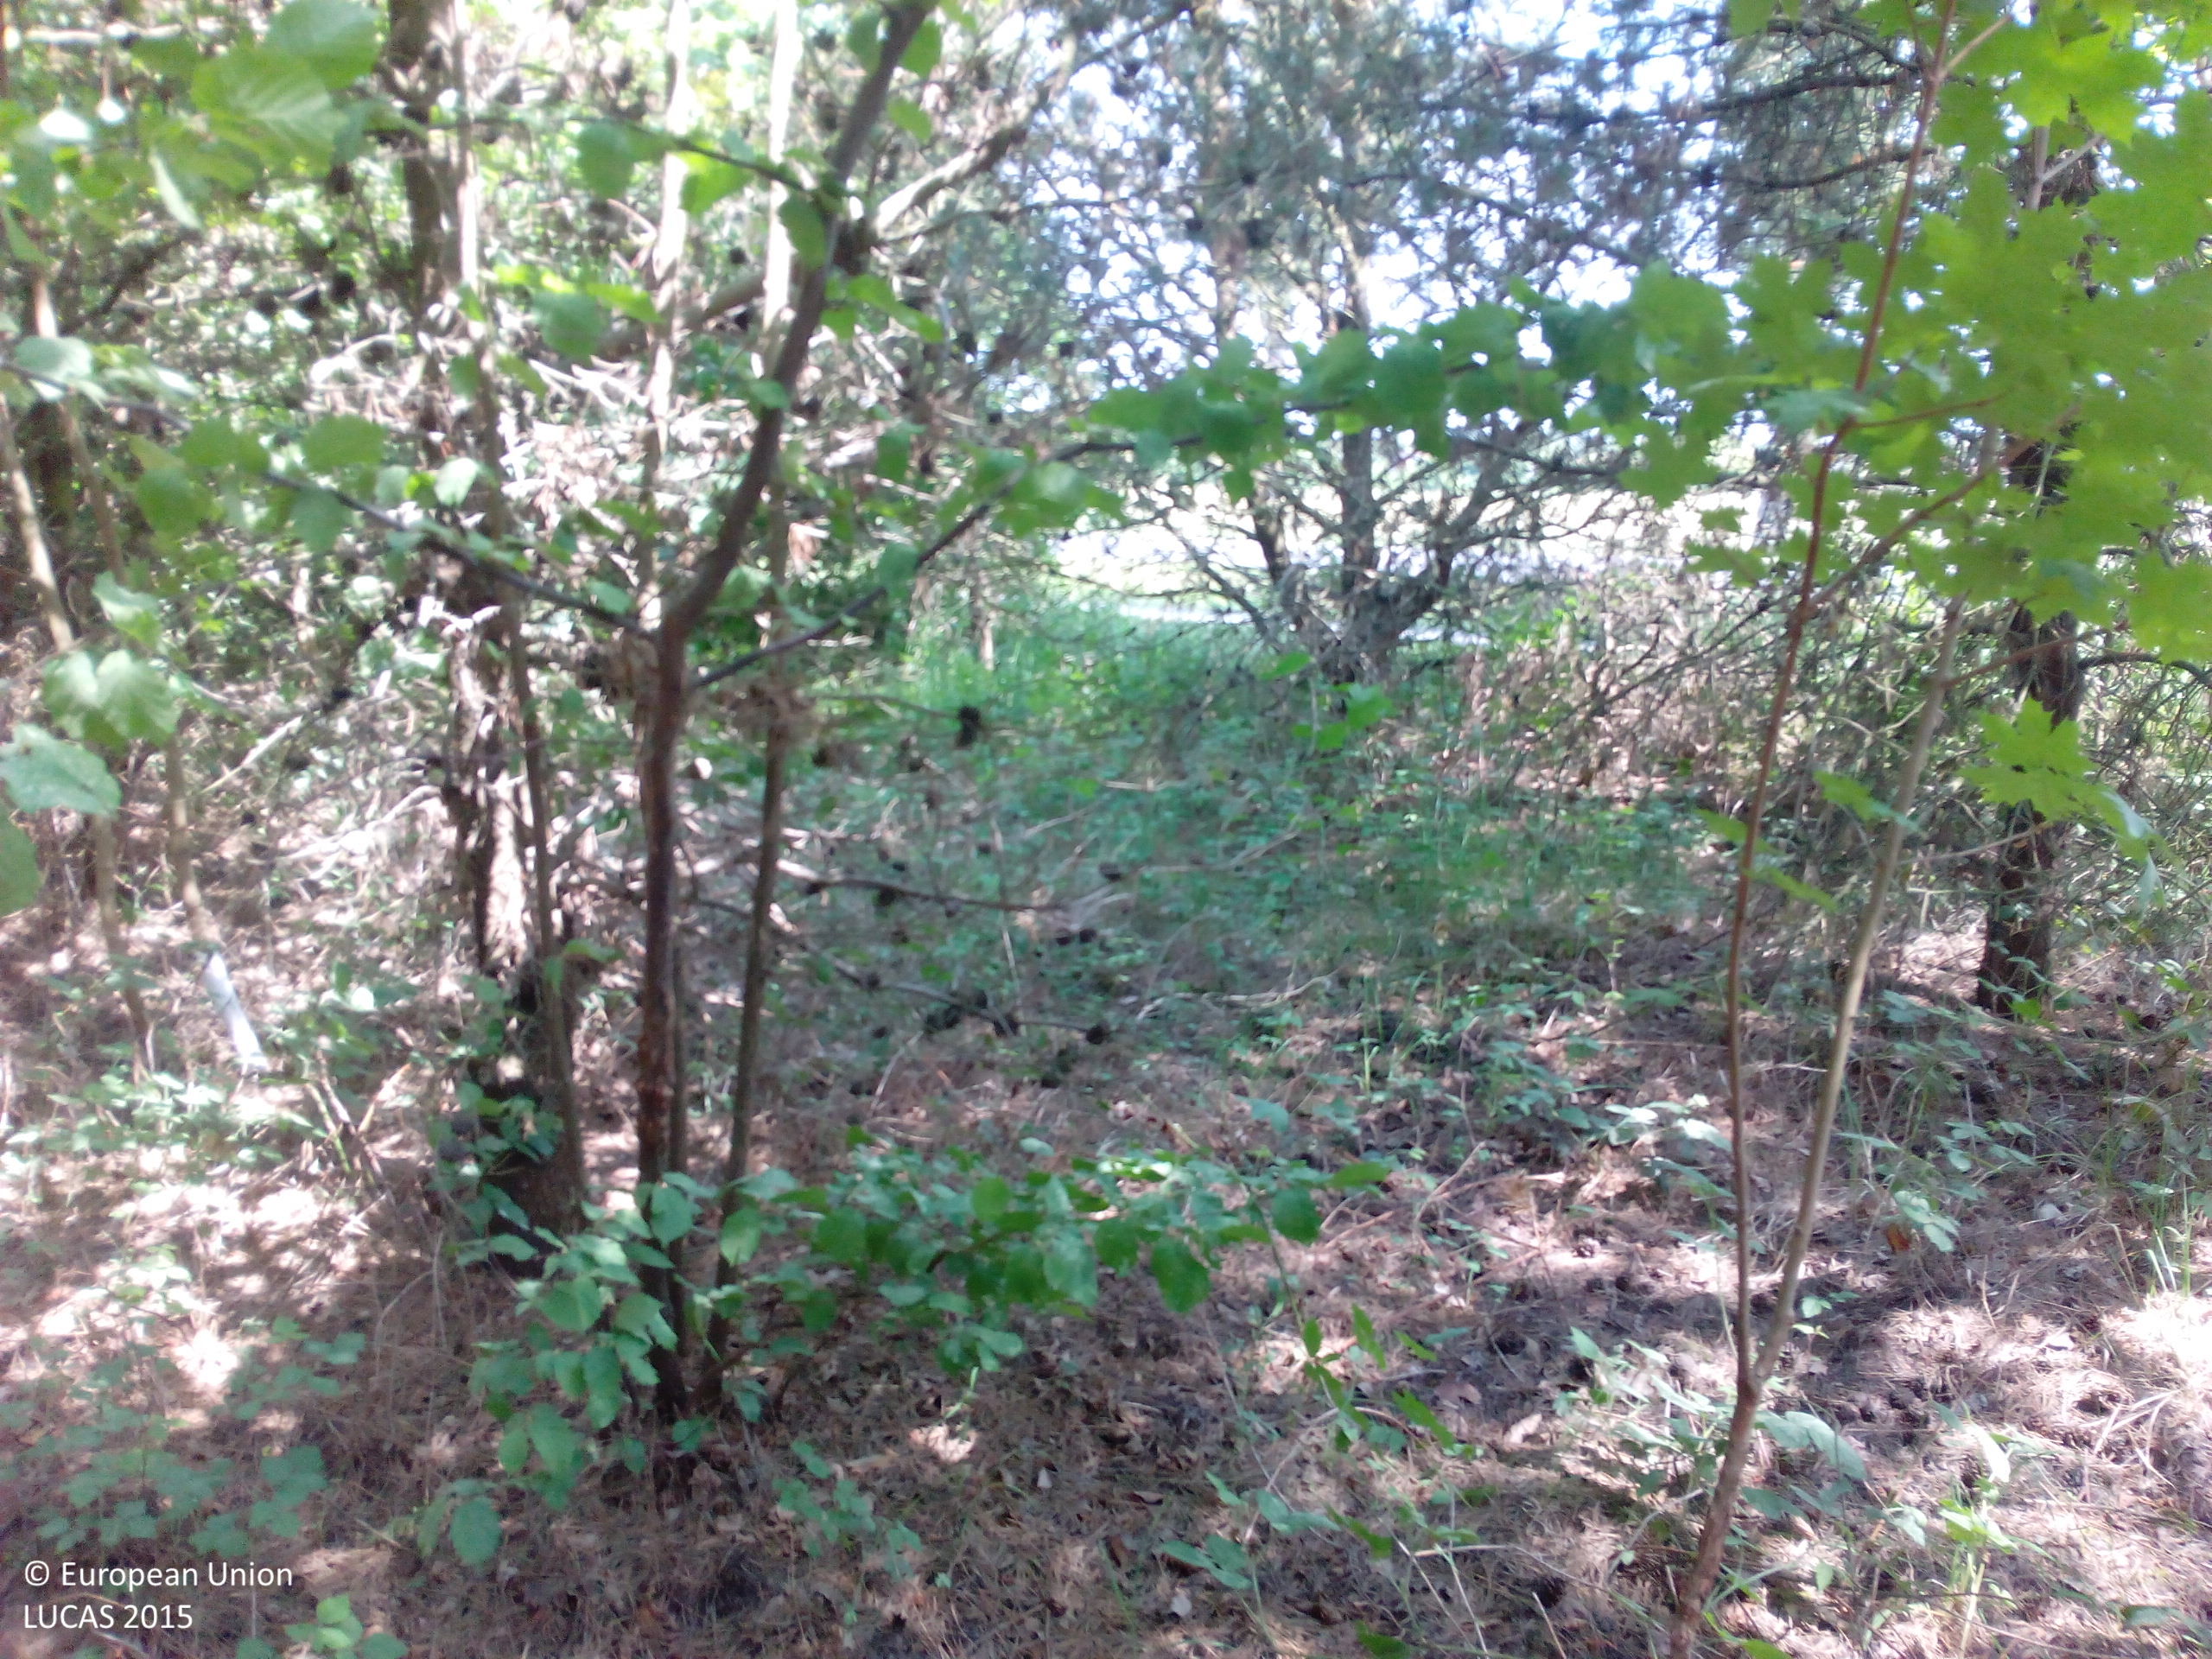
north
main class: Woodland
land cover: Pine dominated mixed woodland
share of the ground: > 75 %
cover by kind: coniferous forest trees 50 %, broadleaved forest trees 50 %
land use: Forestry
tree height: > 5 m
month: May
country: DE
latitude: 51.6343
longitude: 12.3836
